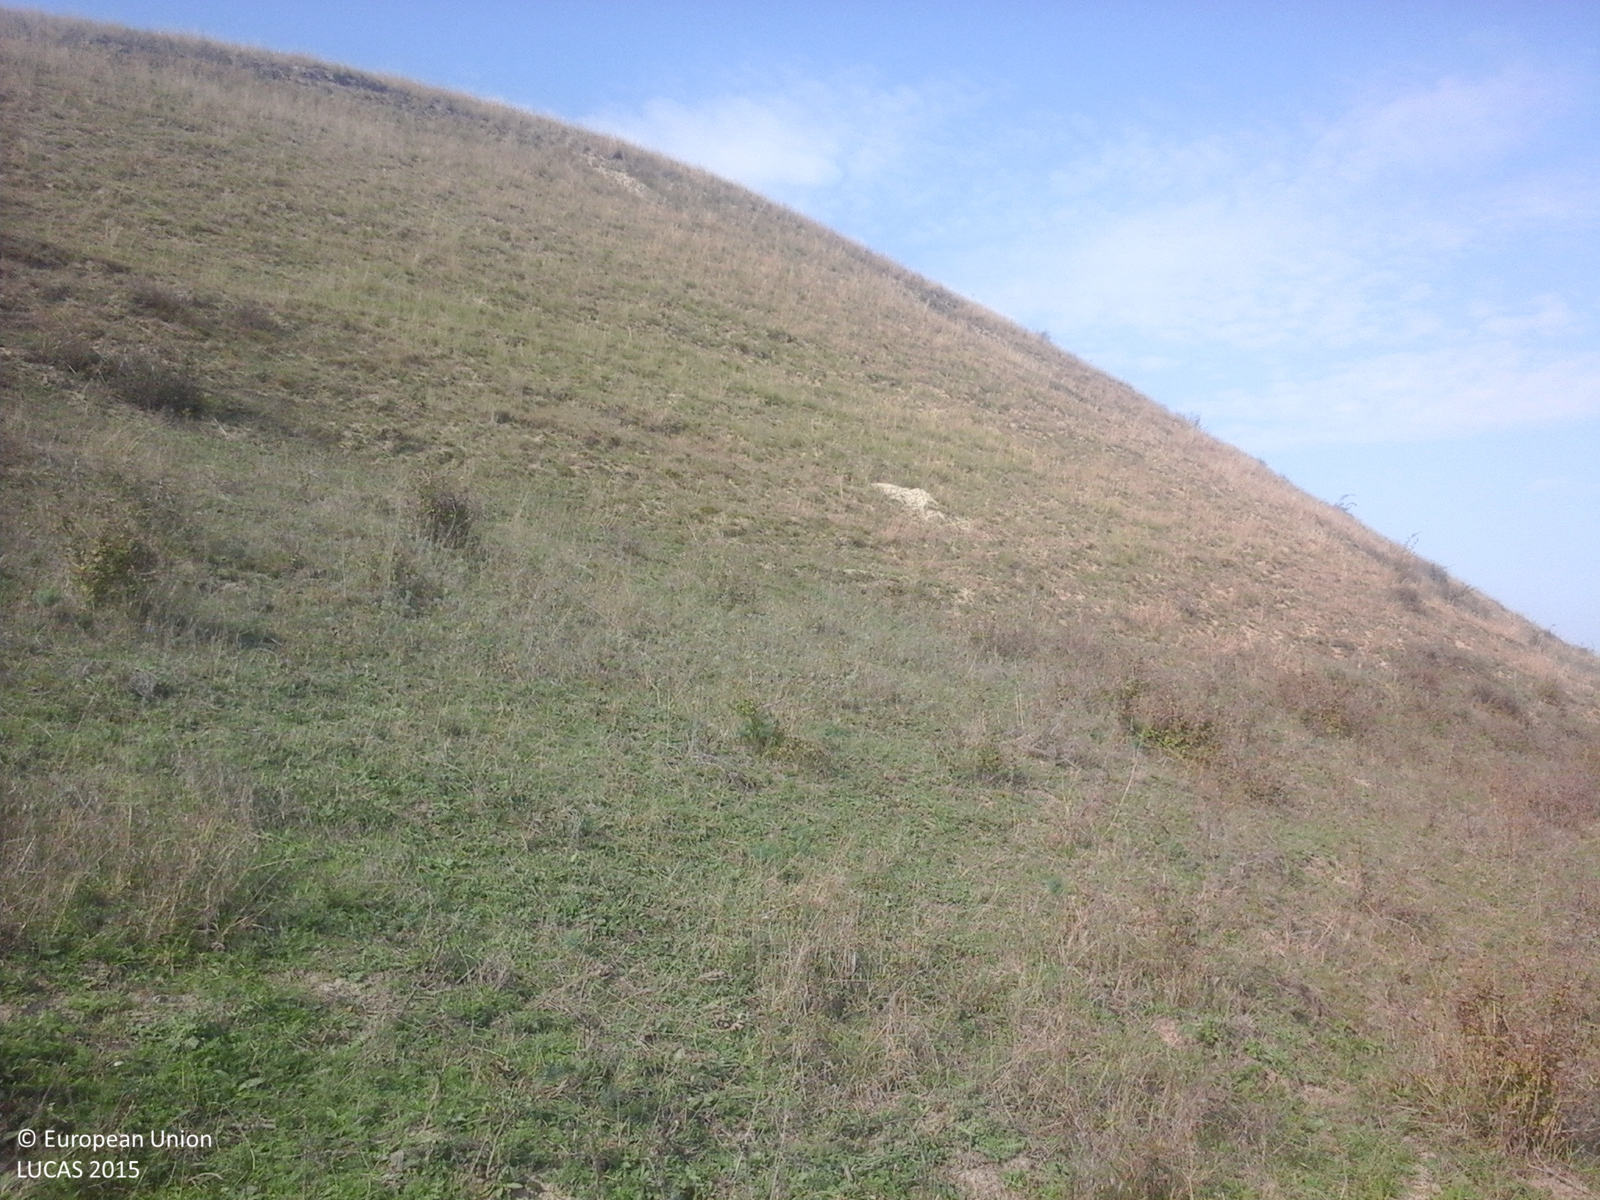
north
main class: Grassland
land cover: Spontaneously vegetated surfaces
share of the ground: > 75 %
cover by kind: herbaceous plants 100 %
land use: Fallow land
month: October
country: RO
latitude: 46.3288
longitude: 23.9344
